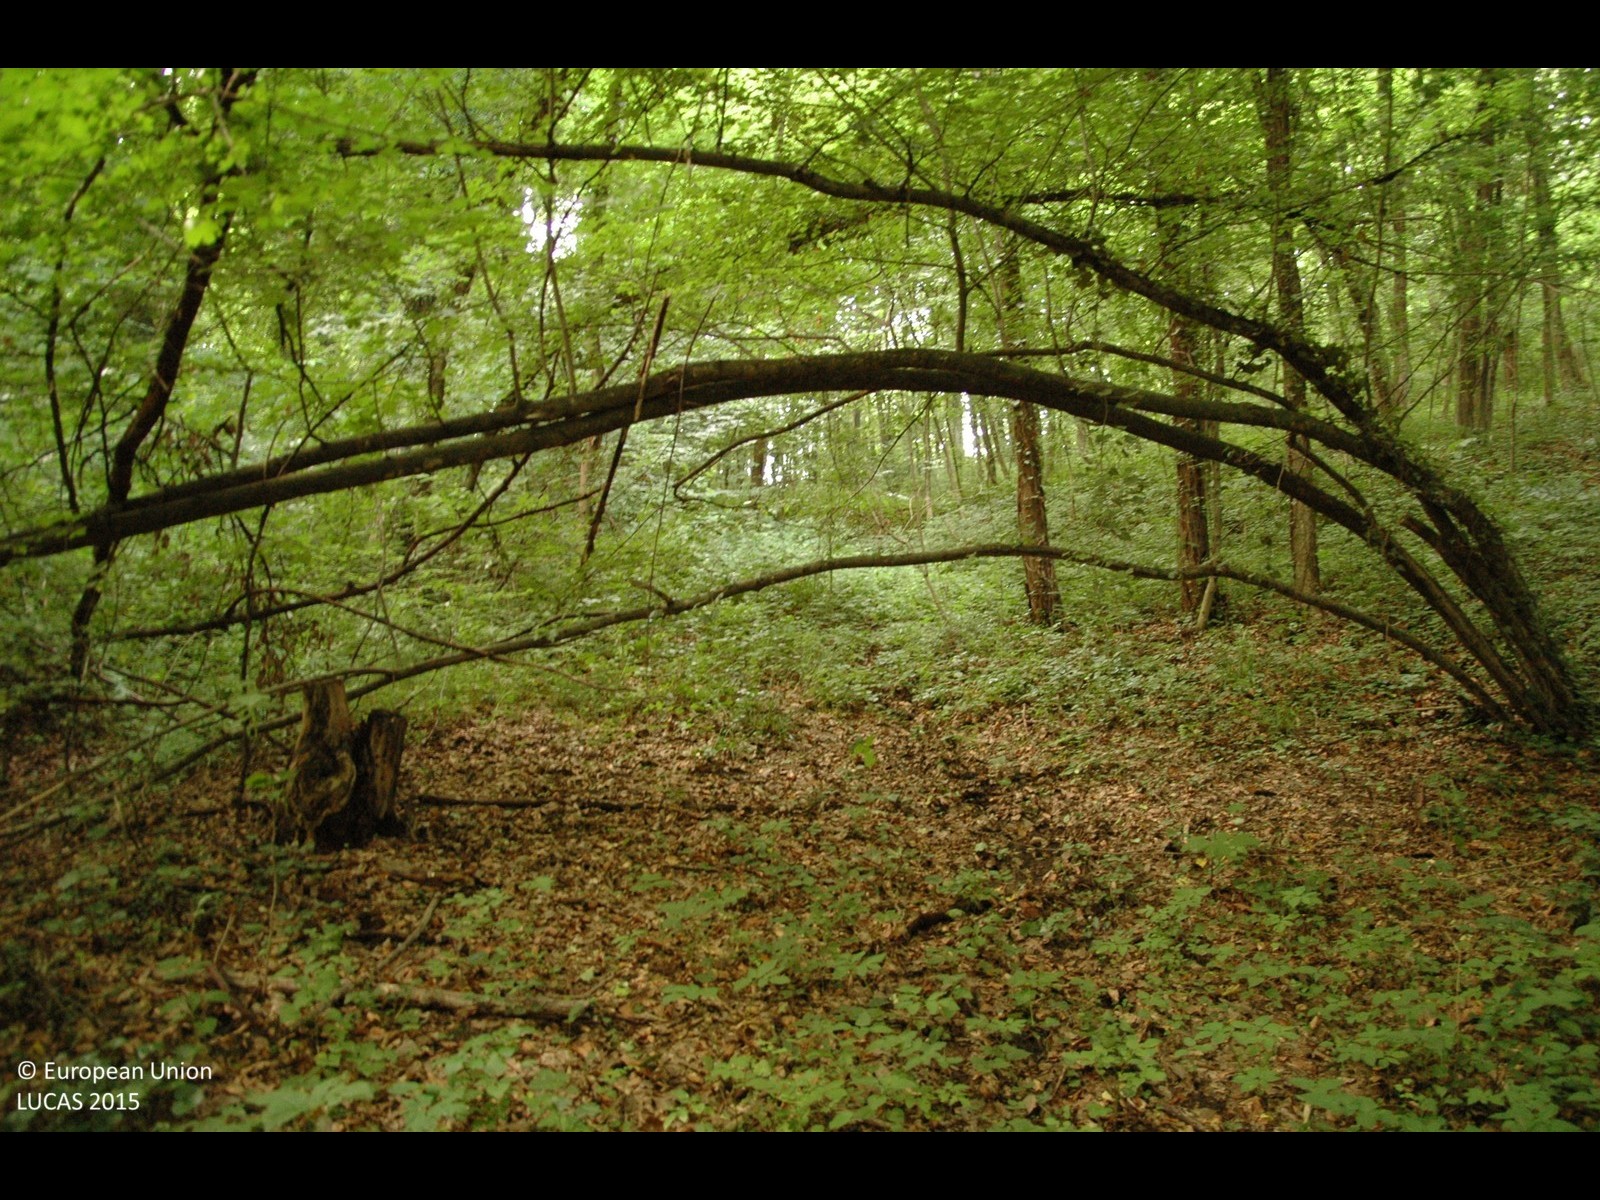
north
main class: Woodland
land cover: Broadleaved woodland
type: mesophytic deciduous forest
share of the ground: > 75 %
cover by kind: broadleaved forest trees 100 %
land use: Forestry
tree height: > 5 m
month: June
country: HR
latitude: 46.2275
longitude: 16.4702
